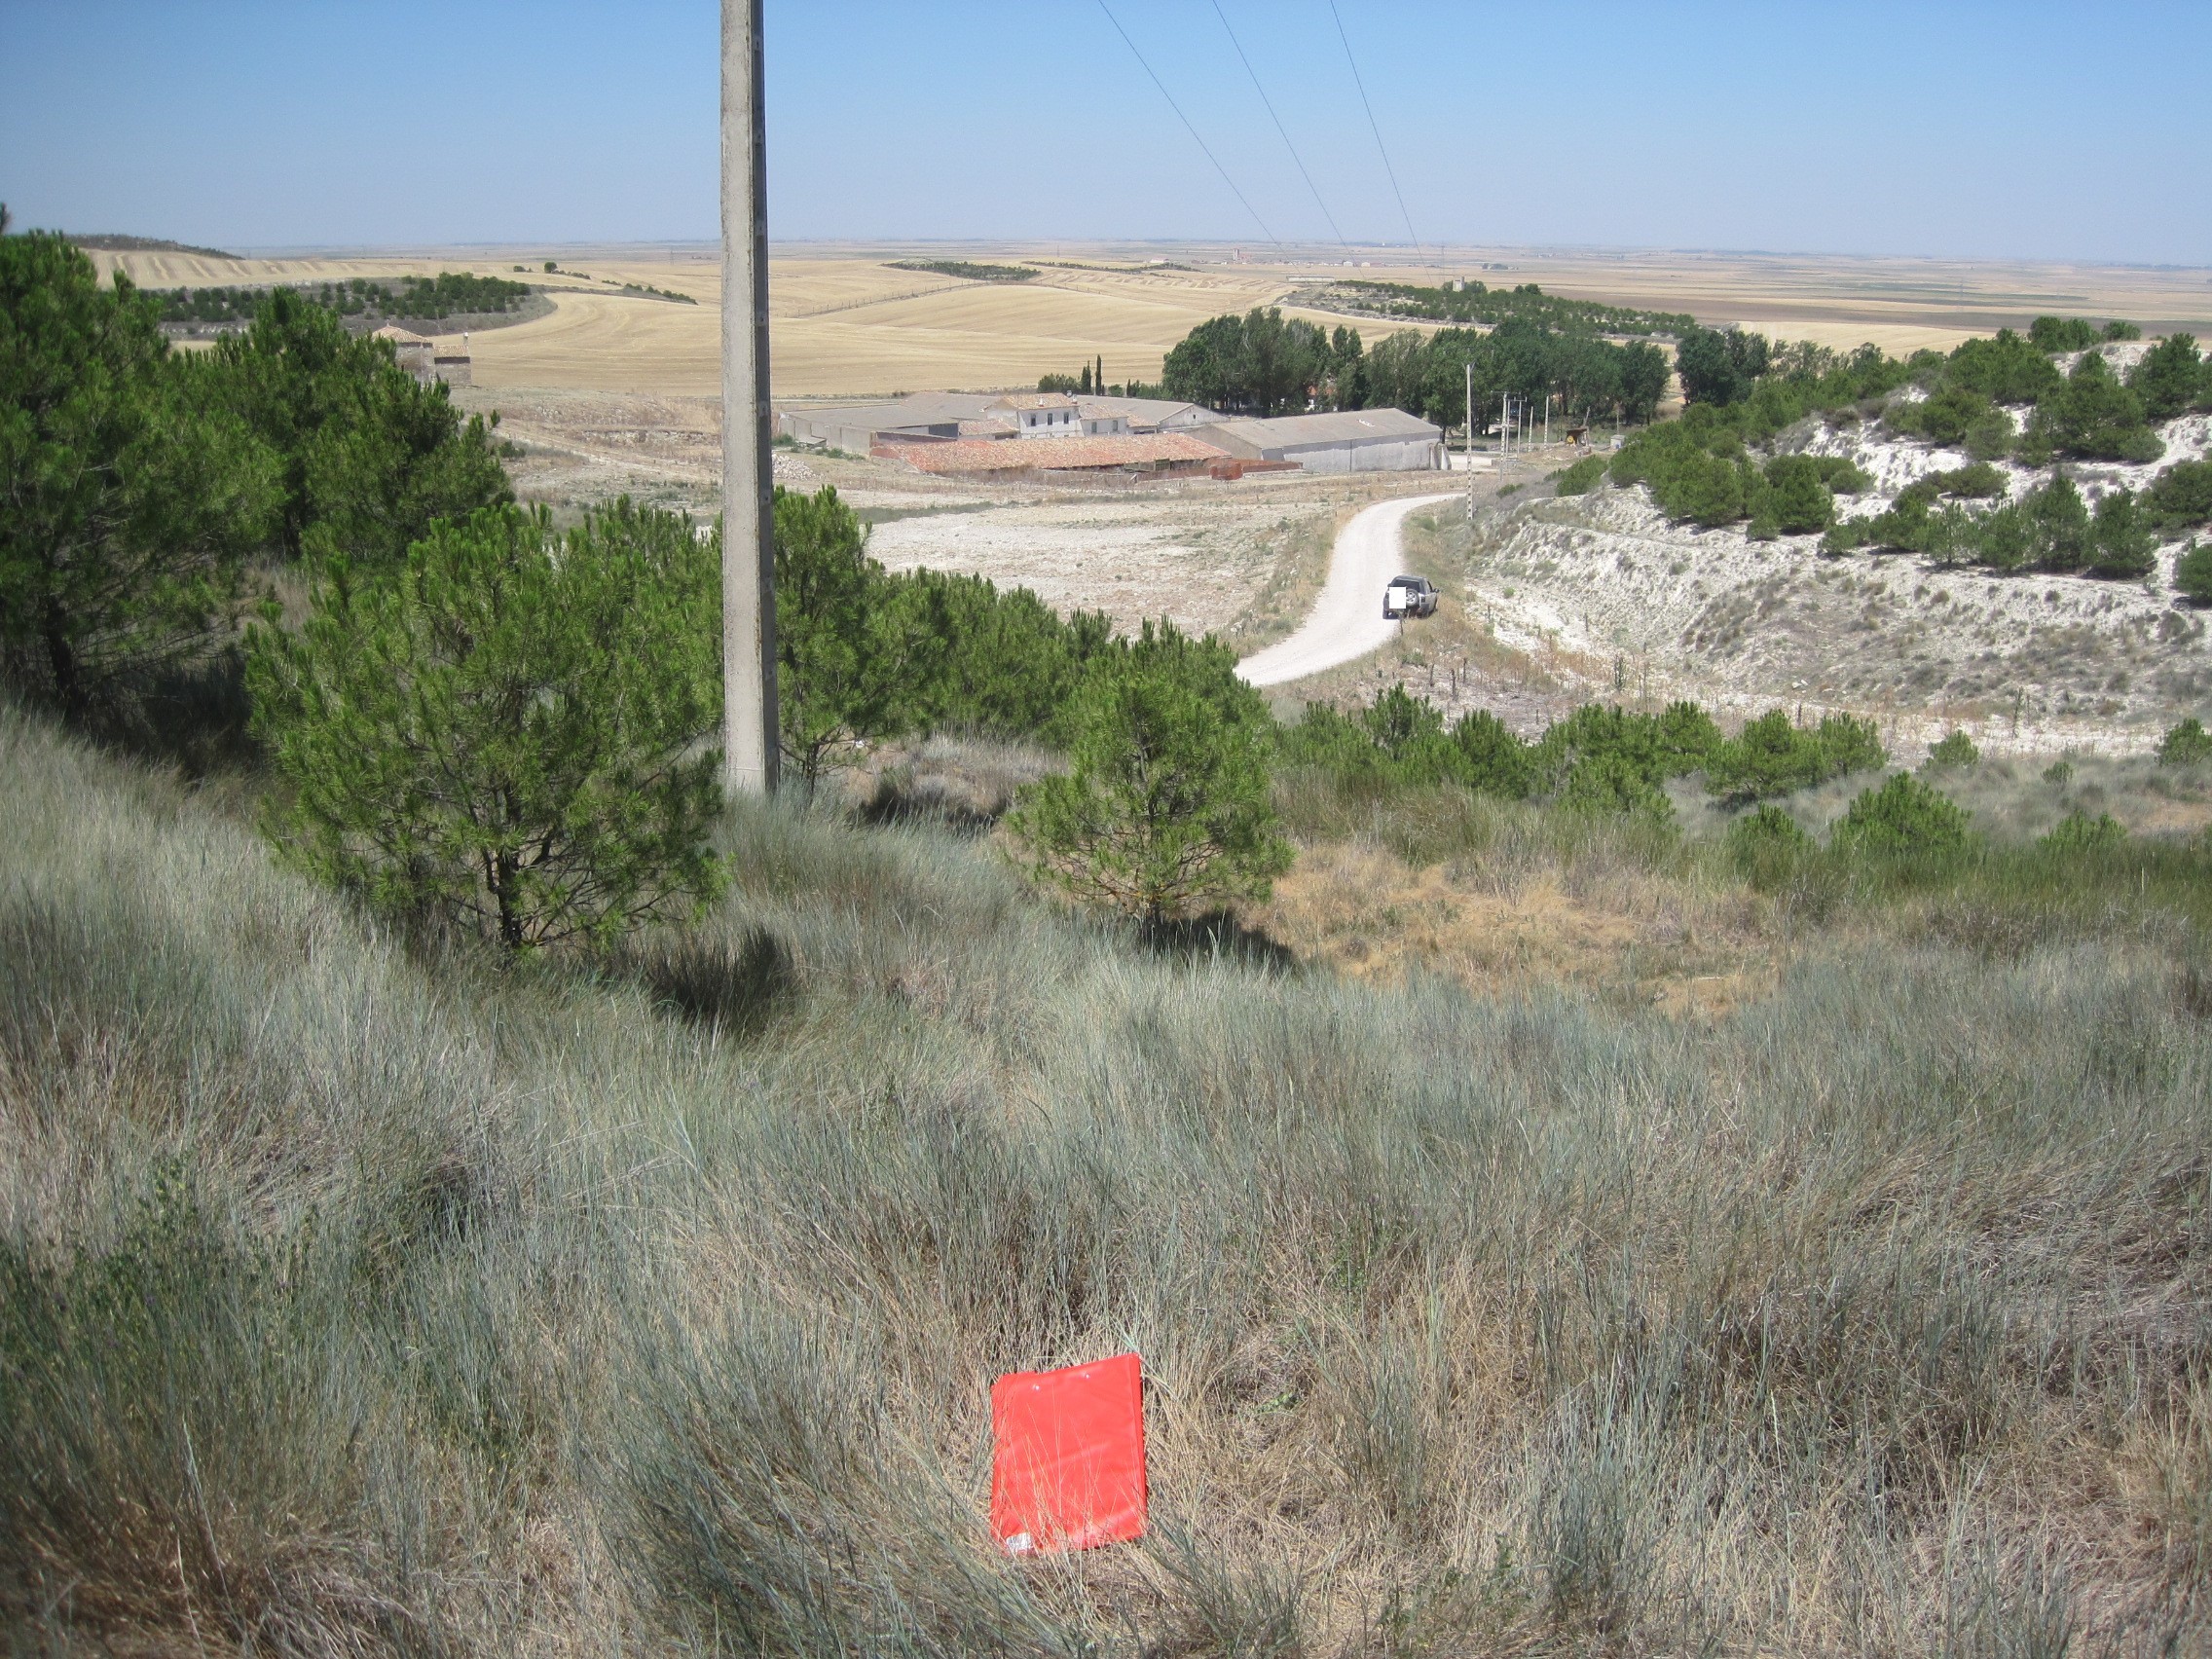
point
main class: Woodland
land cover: Pine dominated coniferous woodland
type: coniferous forest of the mediterranean region
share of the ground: 25 - 50 %
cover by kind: herbaceous plants 60 %, coniferous forest trees 40 %
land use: Semi-natural and natural areas not in use
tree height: > 5 m
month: July
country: ES
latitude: 41.9621
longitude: -4.6837
